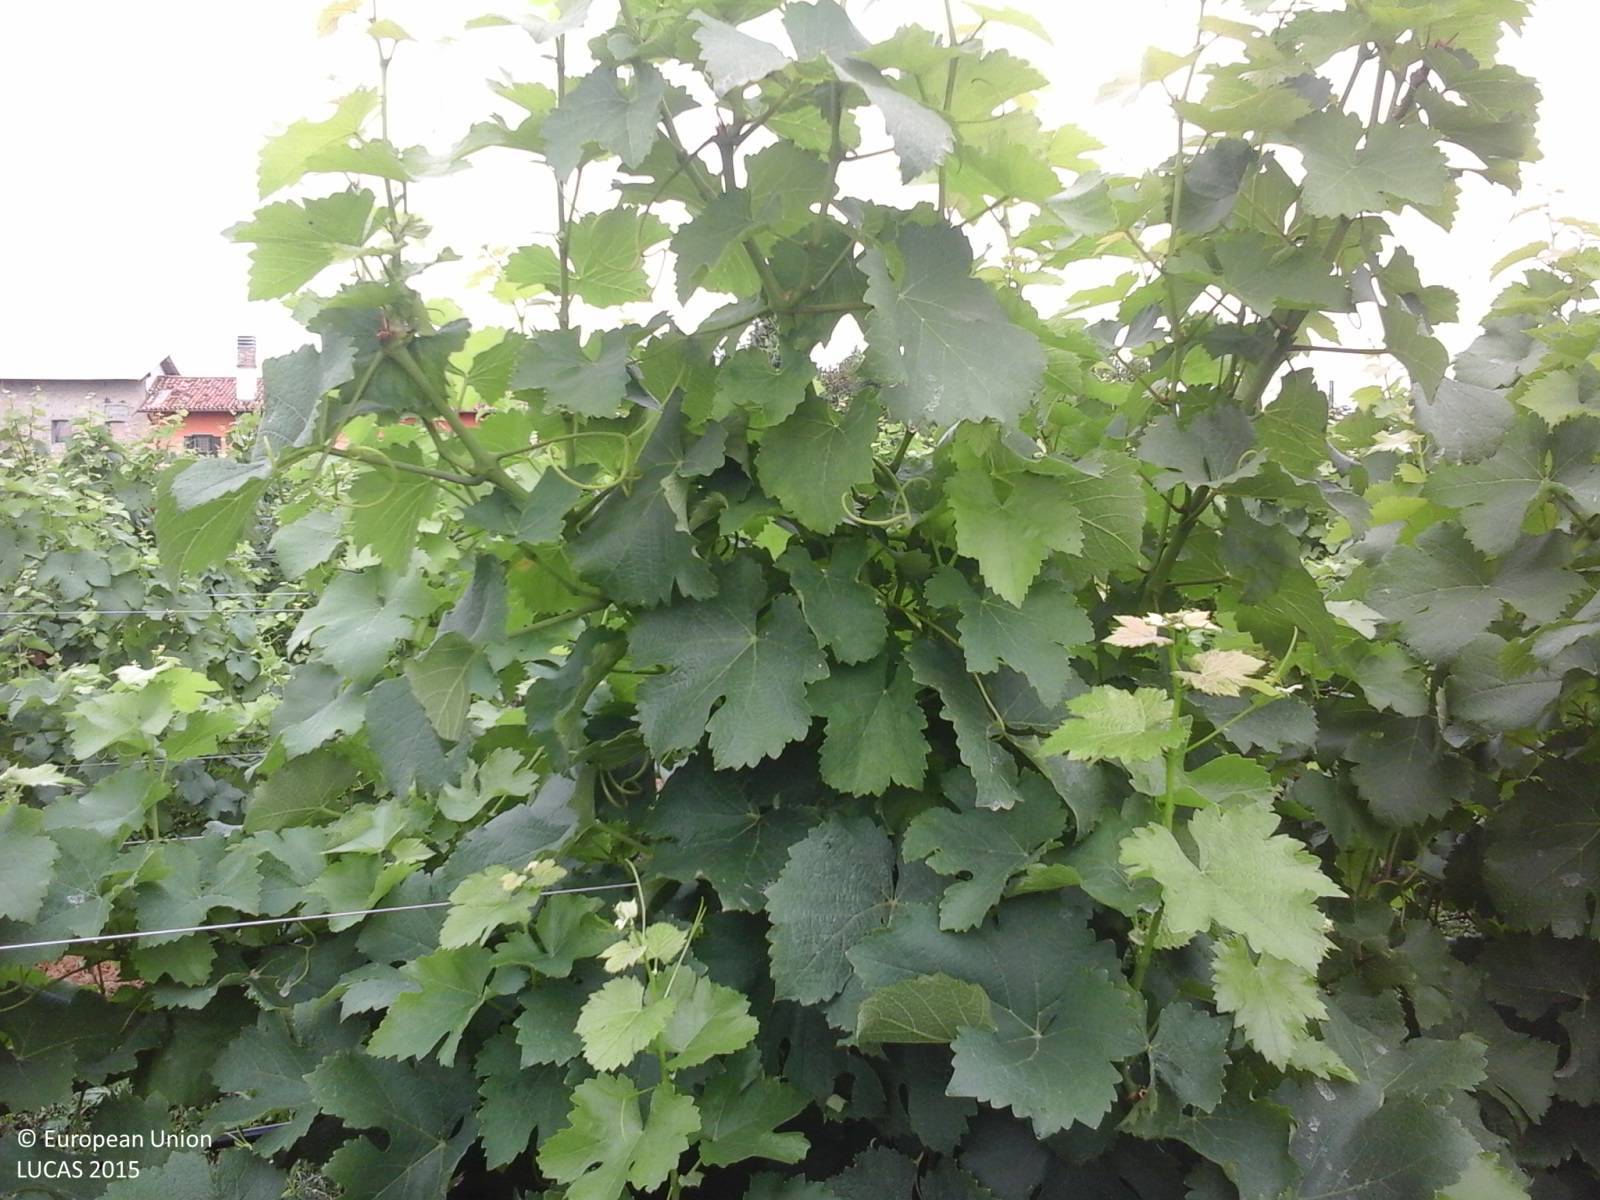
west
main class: Cropland
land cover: Vineyards
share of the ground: 50 - 75 %
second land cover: Grassland without tree/shrub cover
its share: > 75 %
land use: Agriculture (excluding fallow land and kitchen gardens)
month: July
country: IT
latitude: 45.9838
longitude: 13.0299
